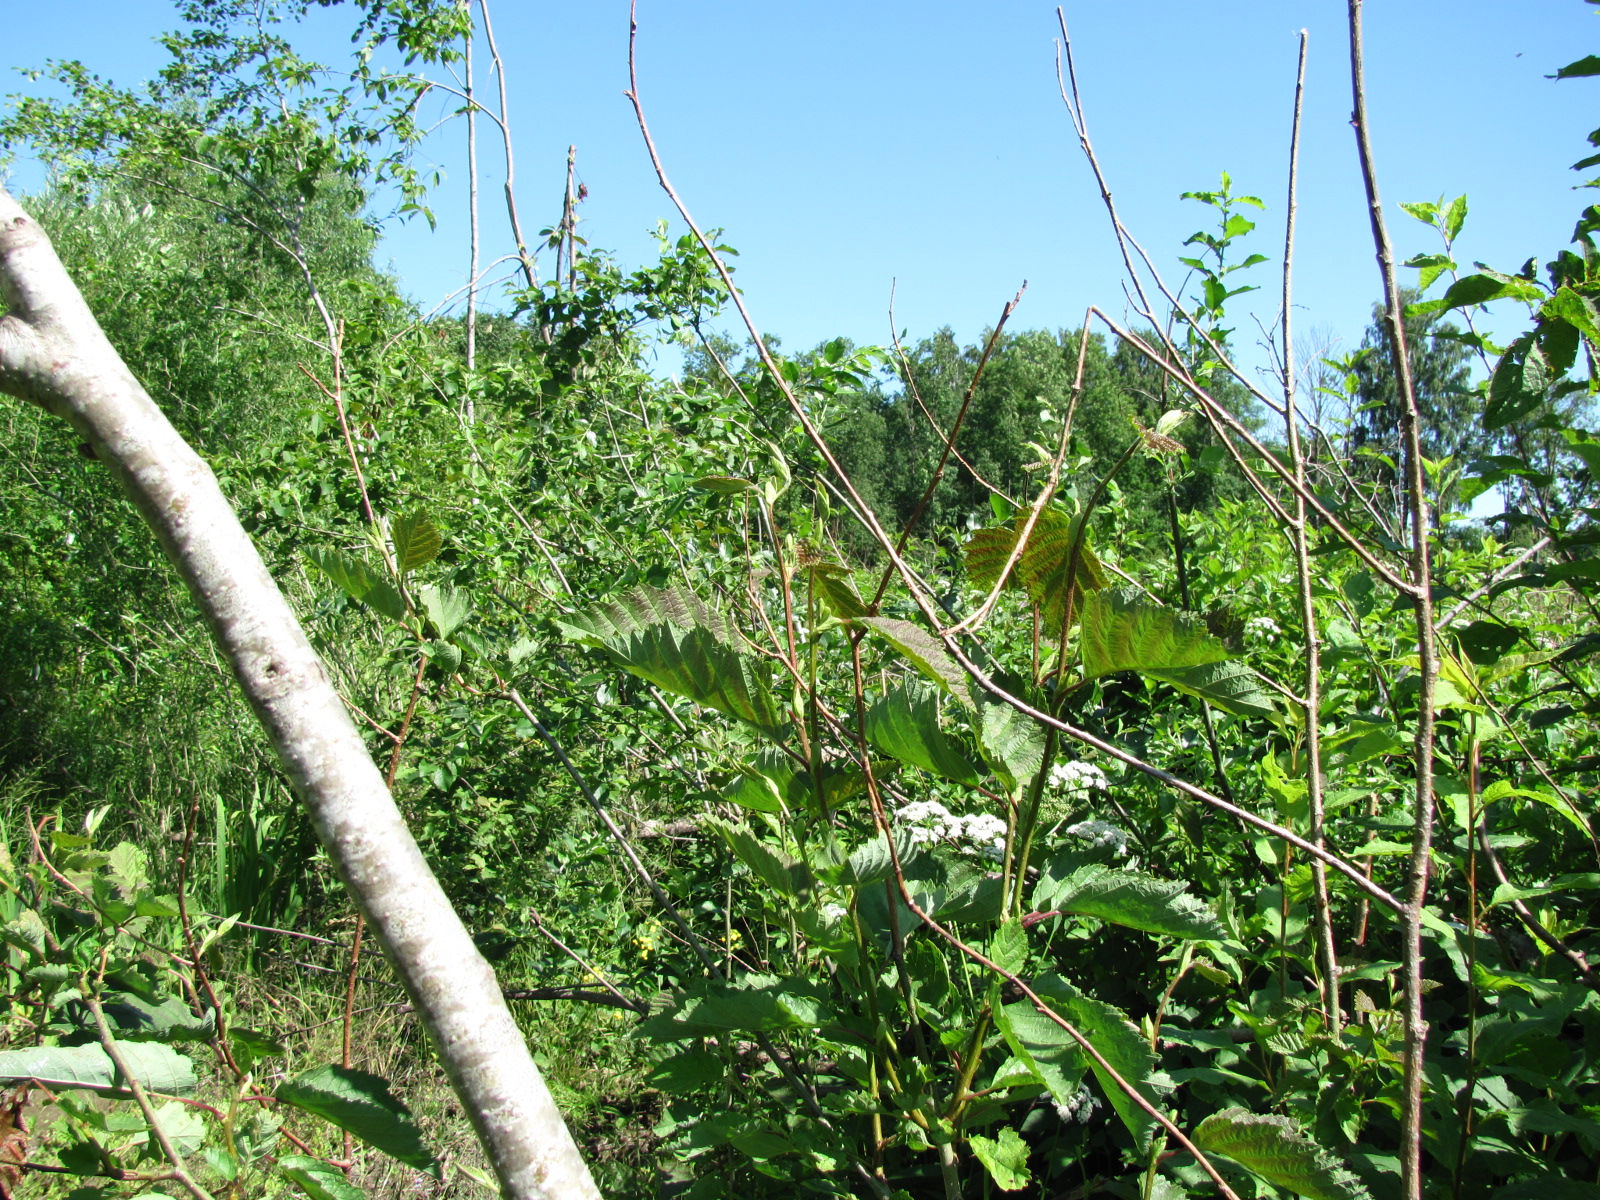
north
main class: Woodland
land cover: Broadleaved woodland
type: non-riverine alder, birch or aspen forest
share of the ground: > 75 %
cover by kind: broadleaved forest trees 100 %
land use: Forestry
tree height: < 5 m
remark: Clear cut
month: June
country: LV
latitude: 56.3595
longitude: 23.8897
